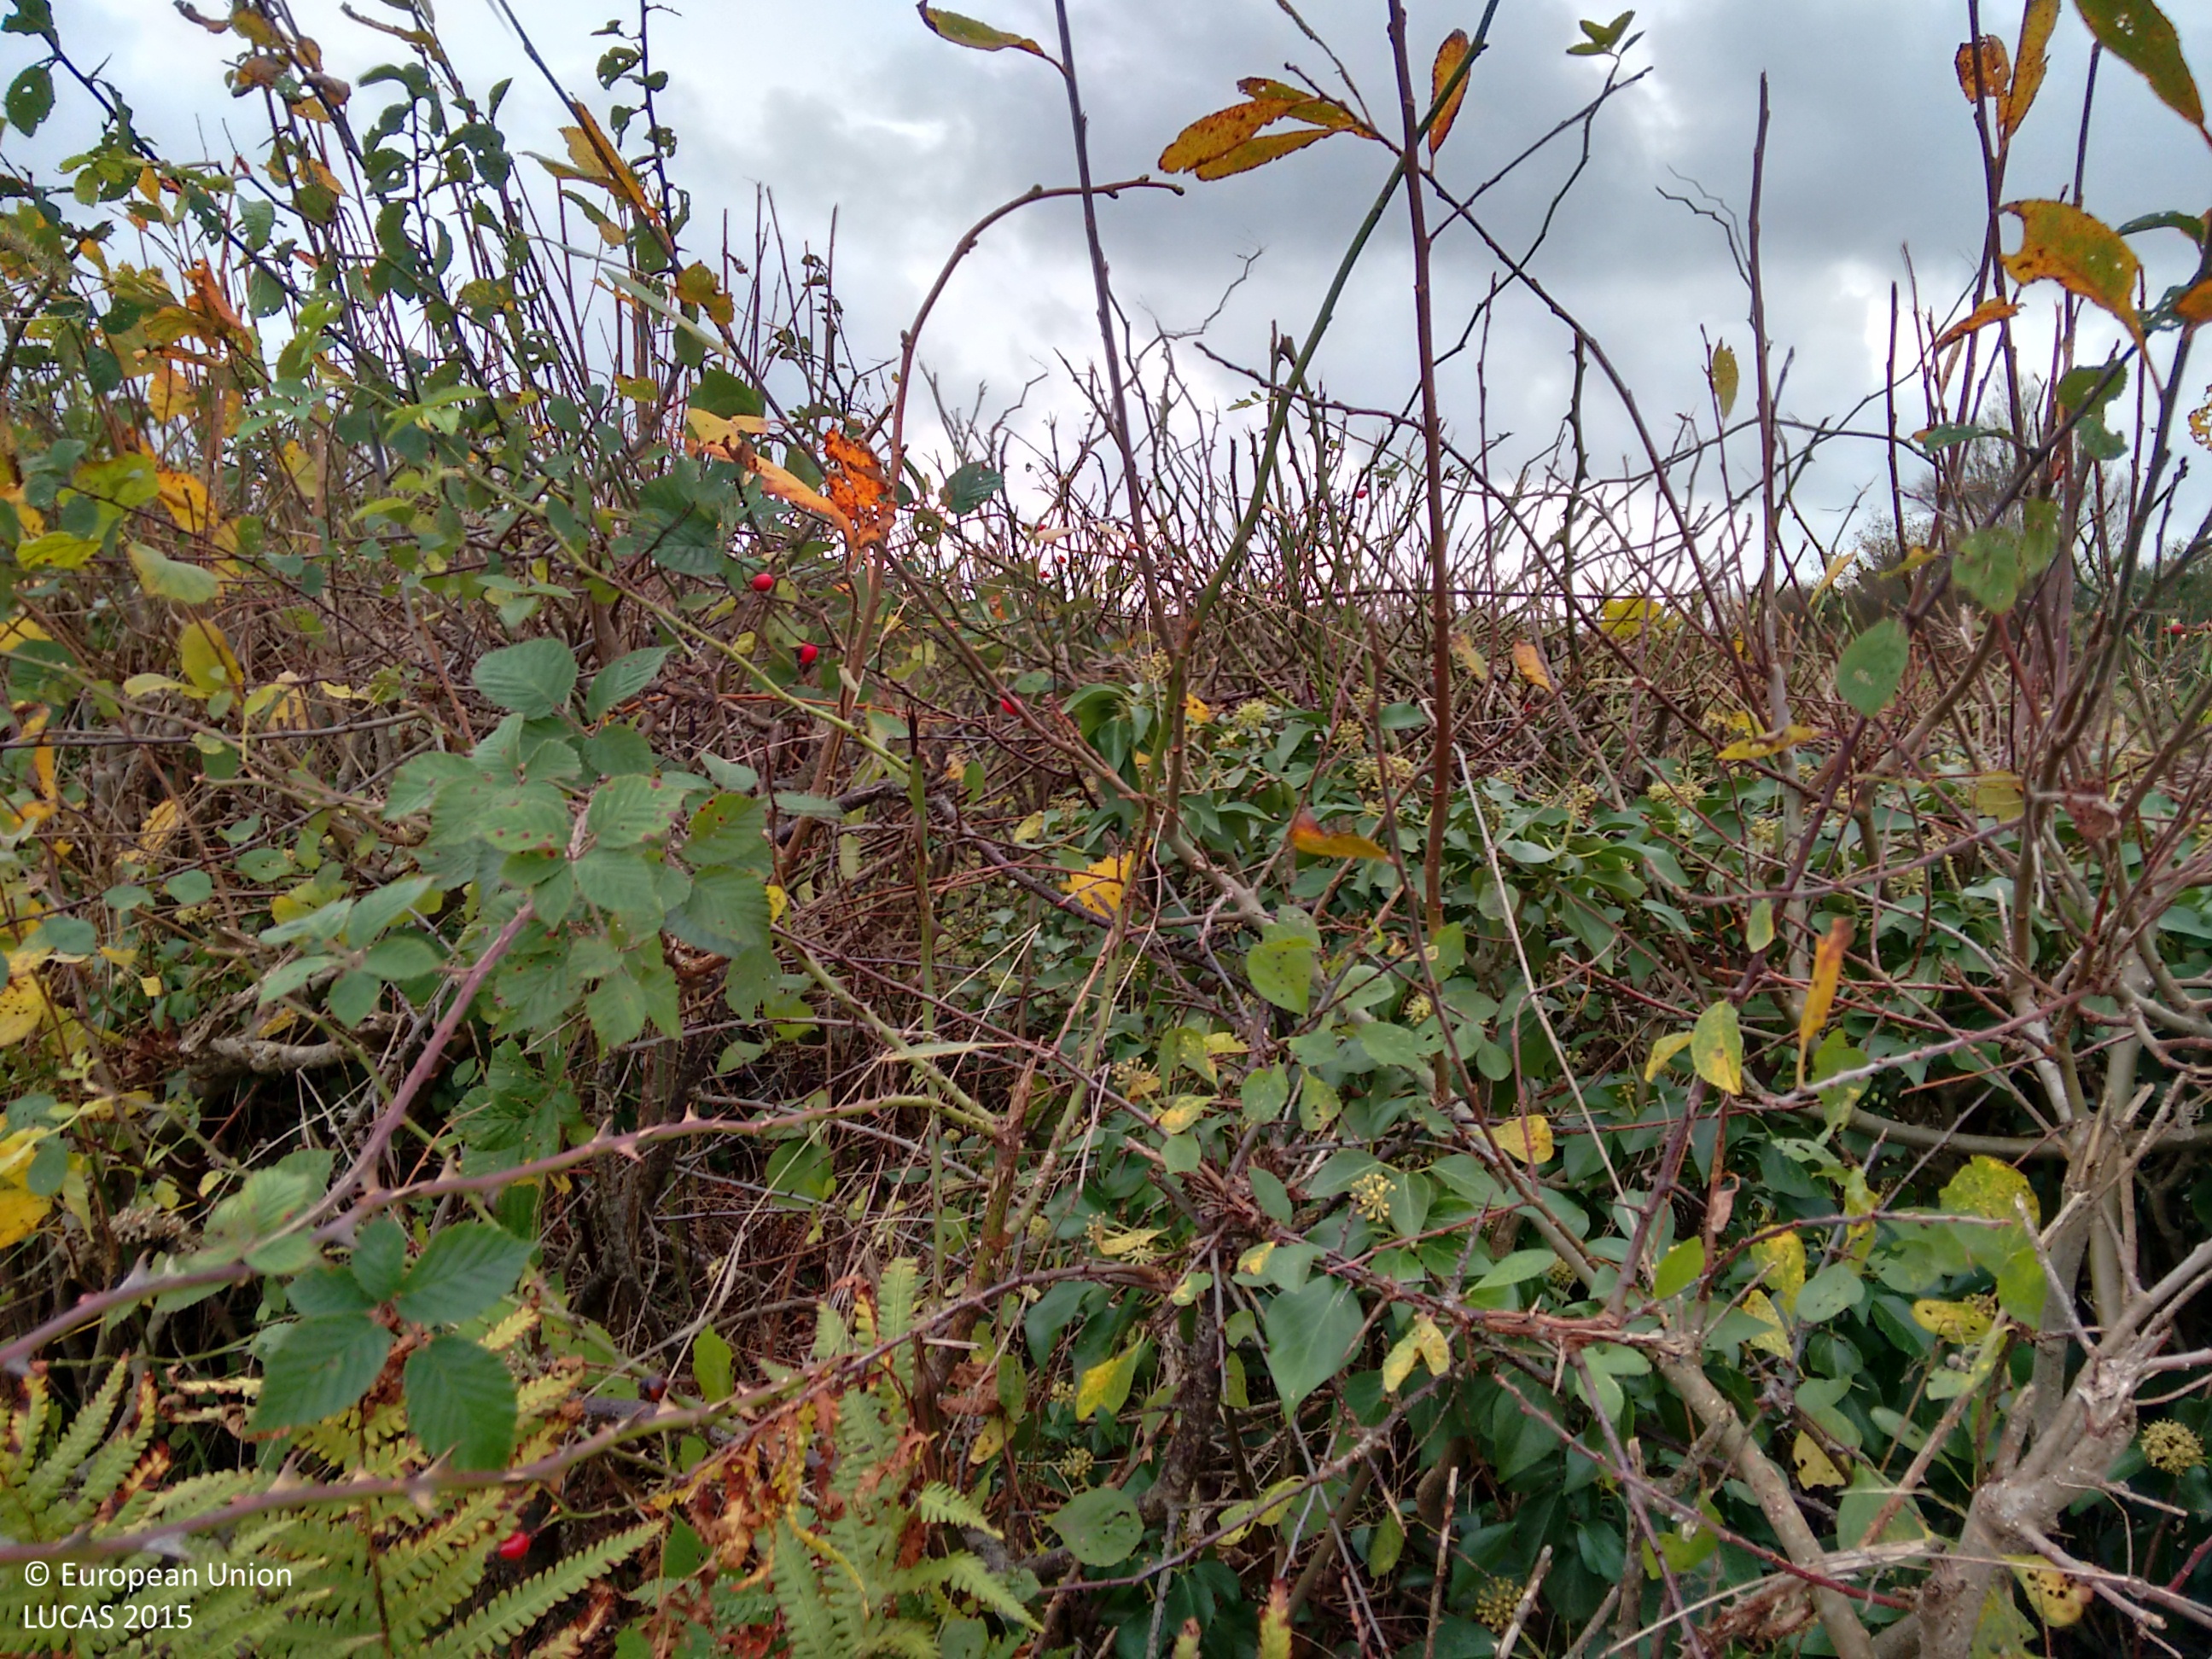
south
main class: Grassland
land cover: Grassland without tree/shrub cover
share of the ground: > 75 %
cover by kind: herbaceous plants 100 %
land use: Agriculture (excluding fallow land and kitchen gardens)
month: November
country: GB
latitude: 54.3329
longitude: -3.3825
